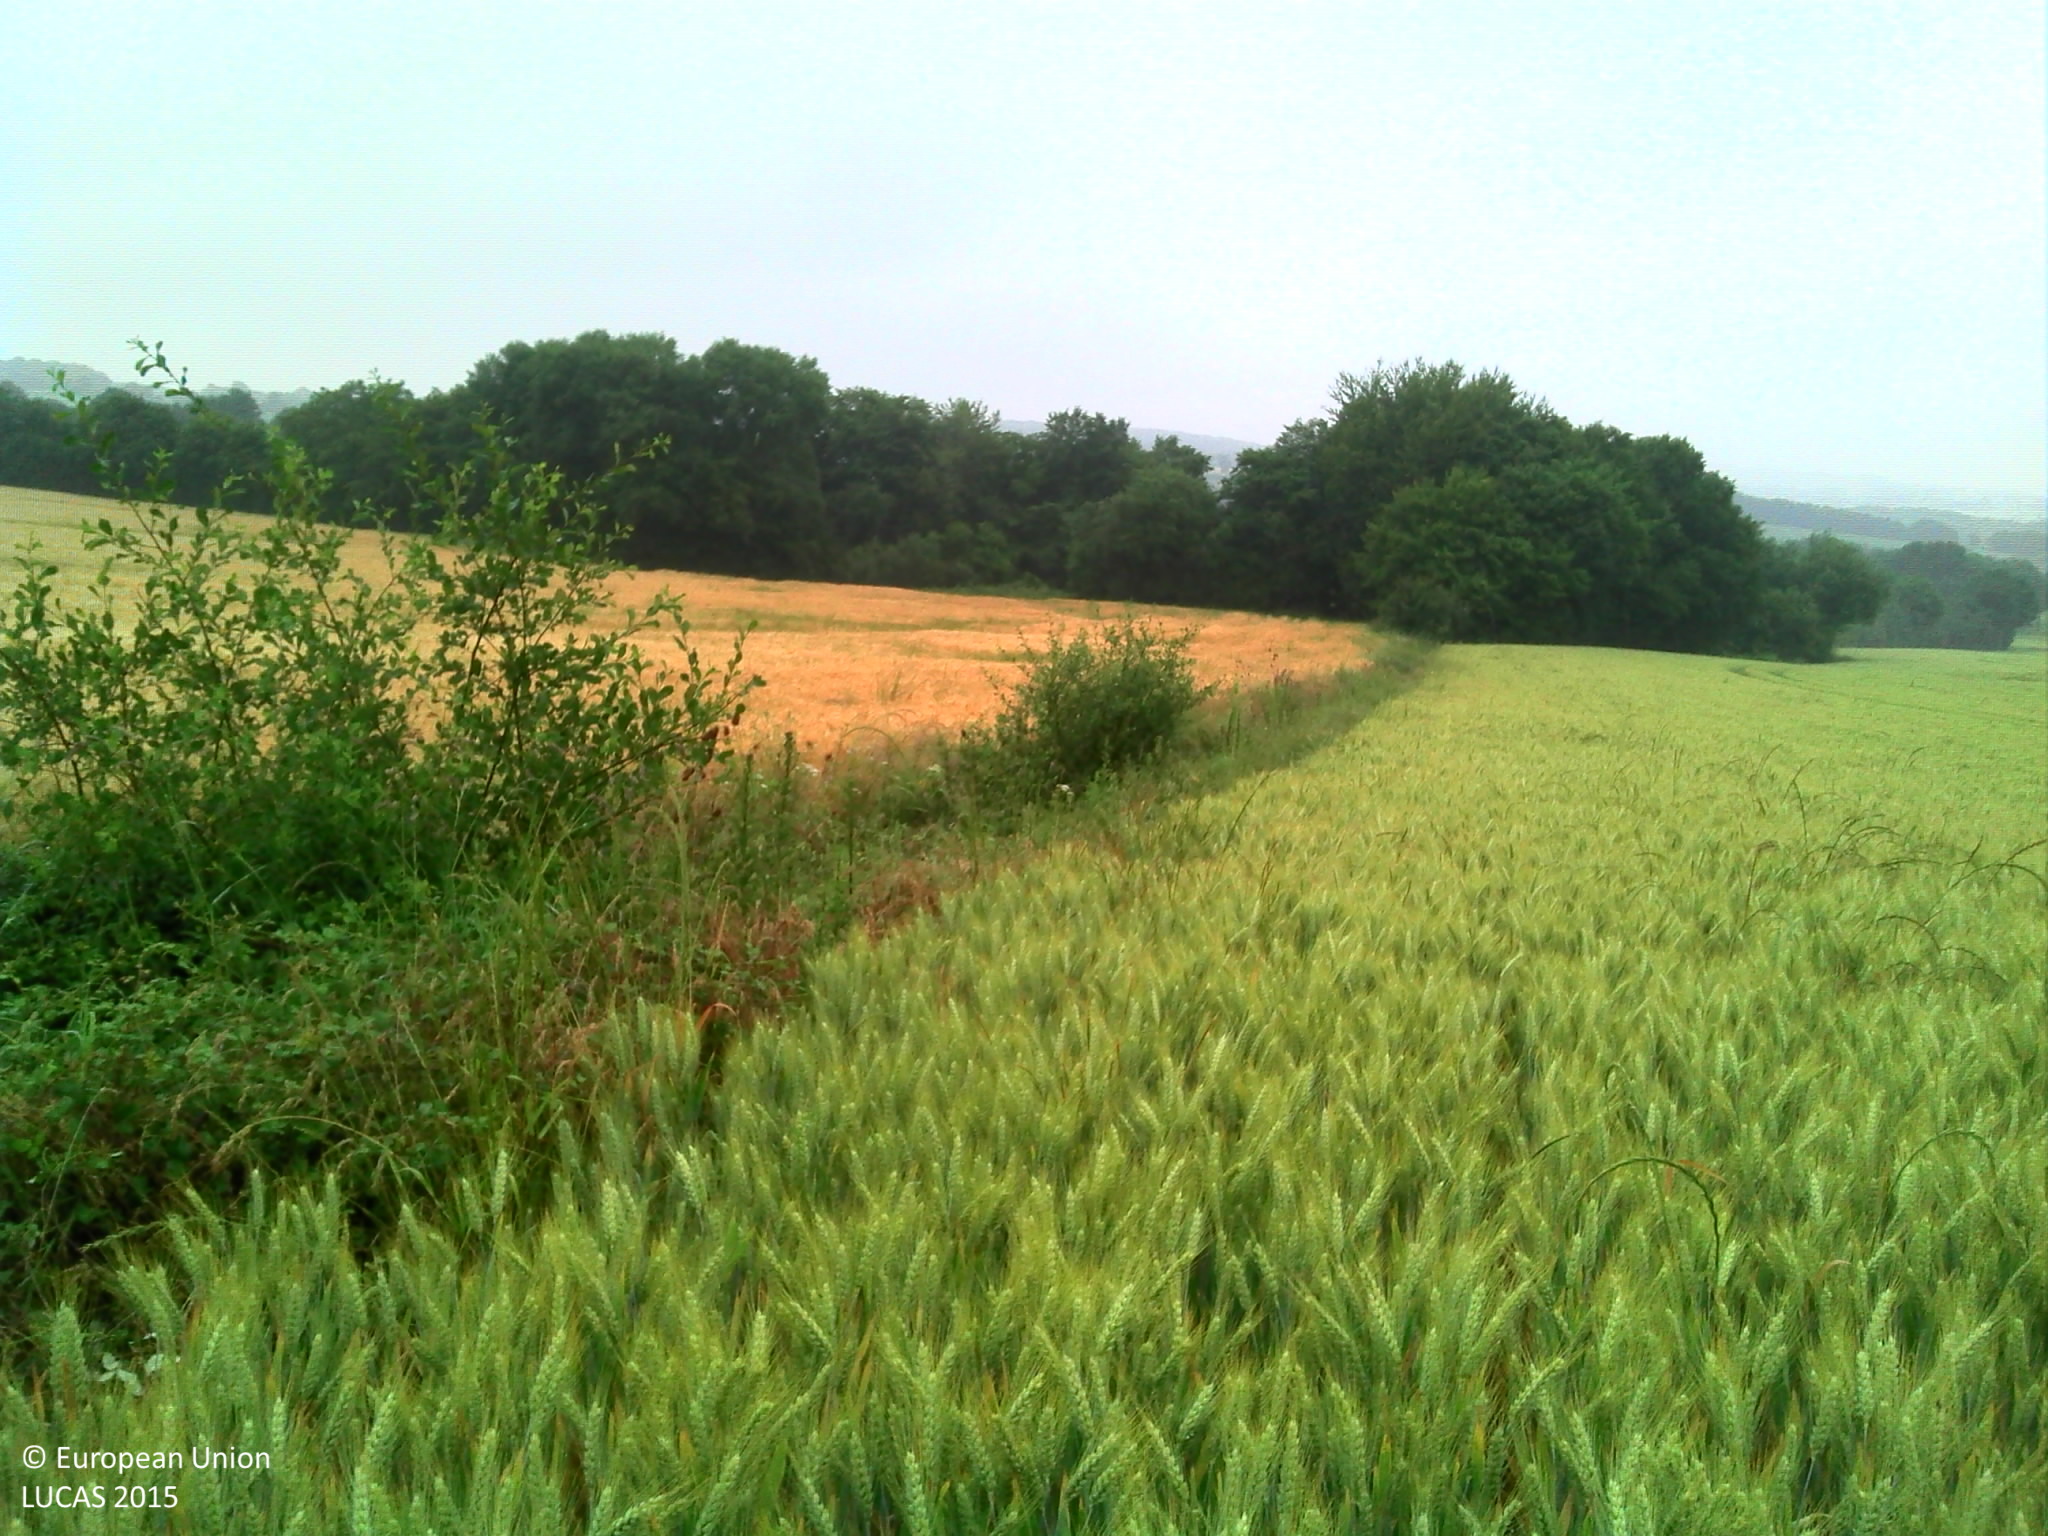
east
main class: Cropland
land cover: Common wheat
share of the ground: > 75 %
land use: Agriculture (excluding fallow land and kitchen gardens)
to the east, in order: Common wheat; Grass margins; Ditches and canals; Barley; Grass margins; Broadleaved woodland; Inland fresh running water; Broadleaved woodland; Fences; Grassland without tree/shrub cover
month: June
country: FR
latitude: 47.4724
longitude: 2.6554
